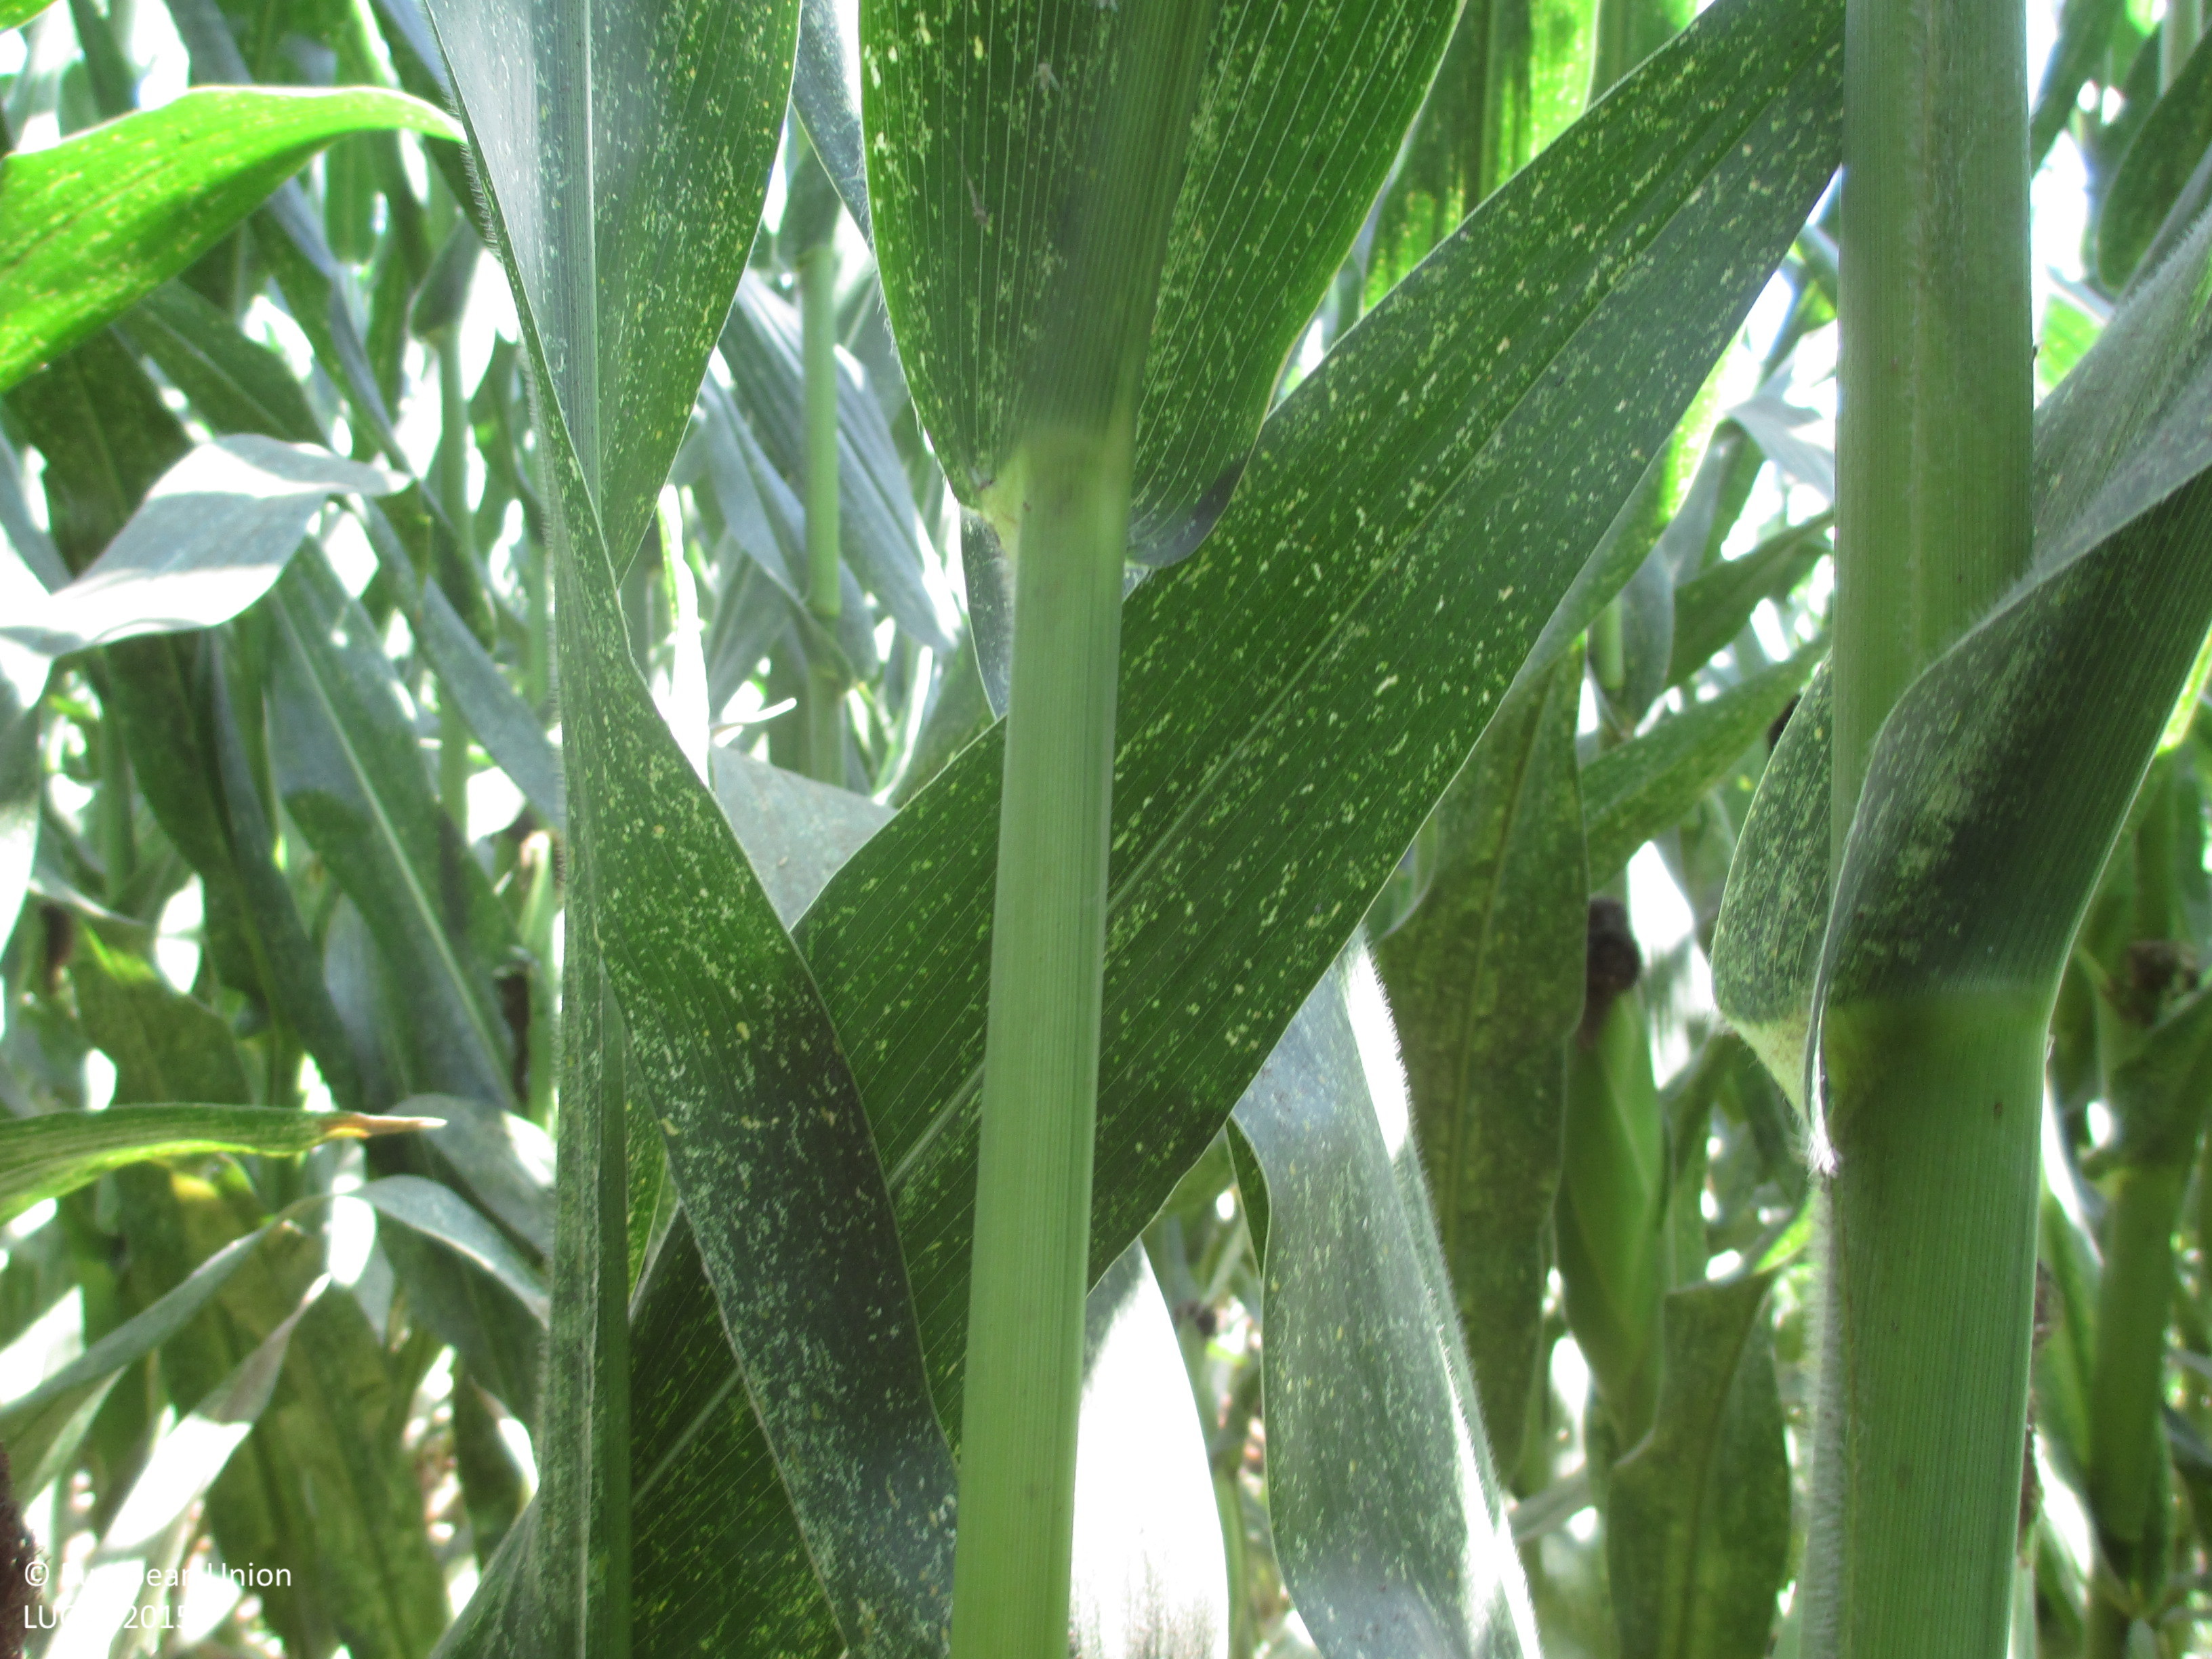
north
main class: Cropland
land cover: Maize
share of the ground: > 75 %
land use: Agriculture (excluding fallow land and kitchen gardens)
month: July
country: ES
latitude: 42.0130
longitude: 0.1893
